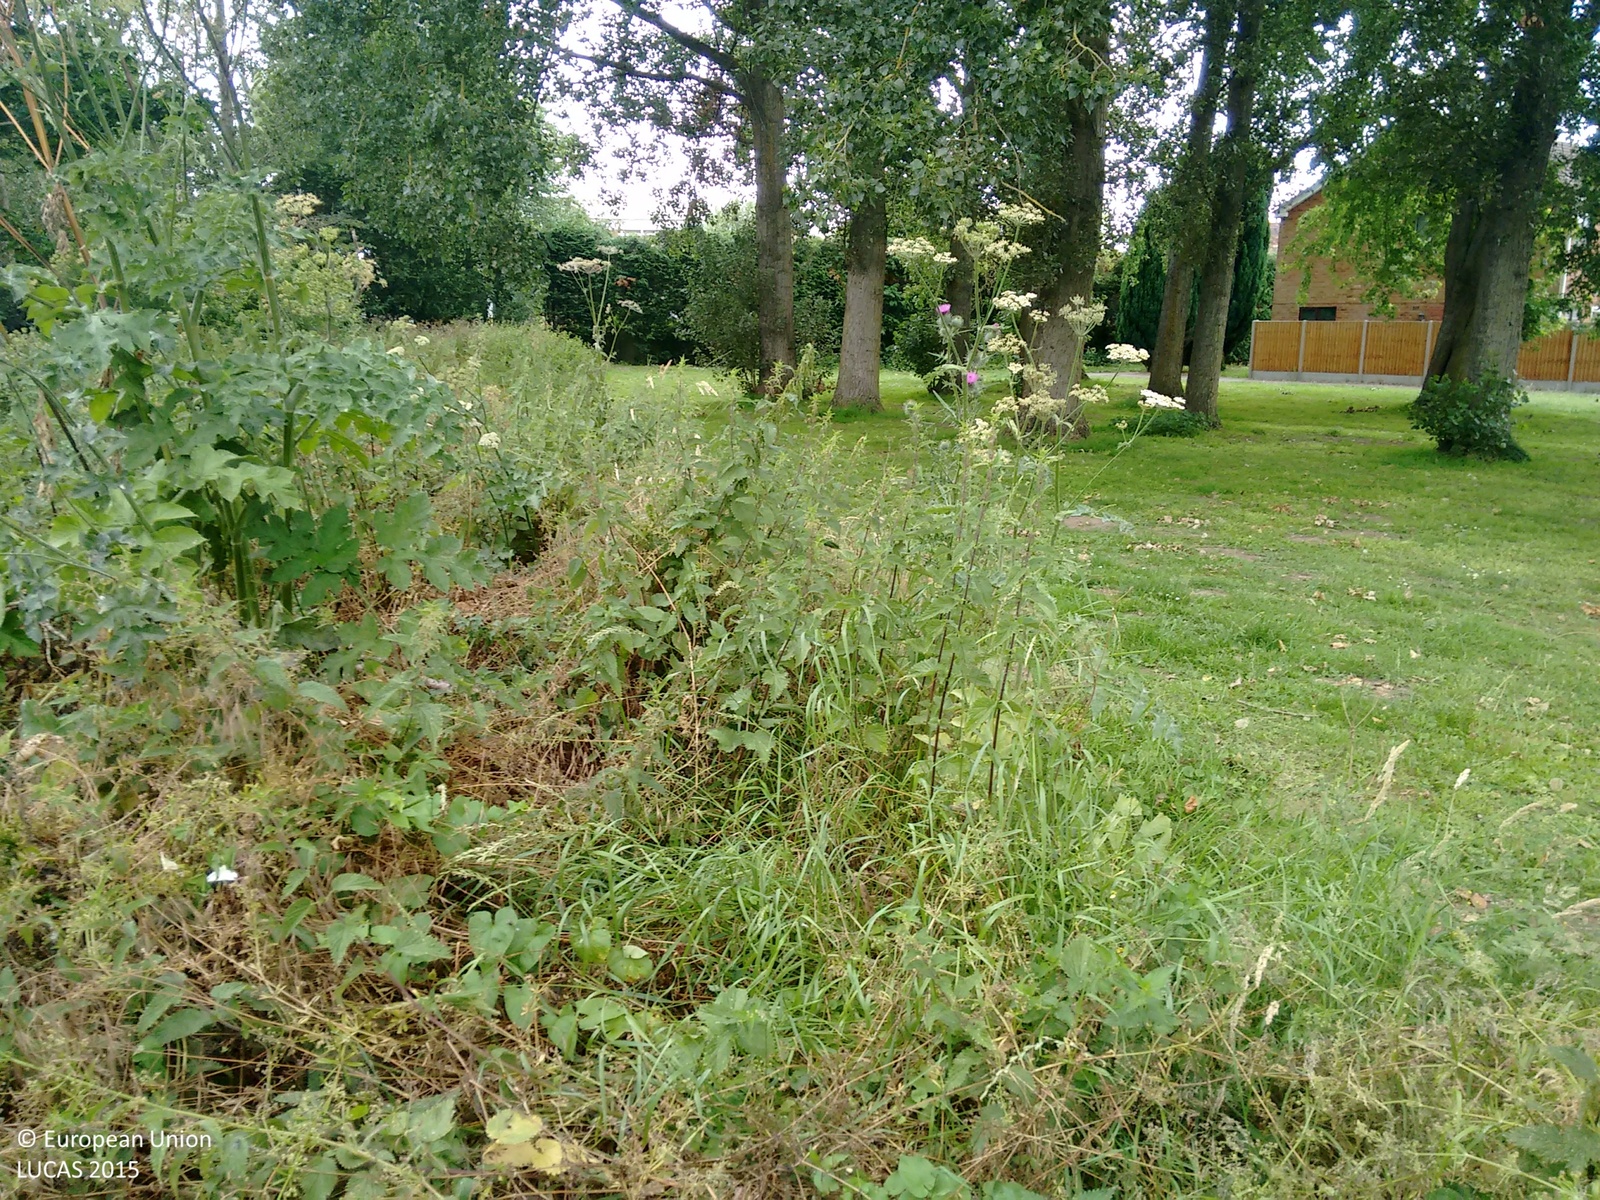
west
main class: Grassland
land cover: Grassland with sparse tree/shrub cover
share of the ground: > 75 %
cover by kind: herbaceous plants 90 %, broadleaved forest trees 5 %, shrubs 5 %
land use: Amenities, museums, leisure
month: July
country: GB
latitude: 52.4034
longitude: -1.4415
